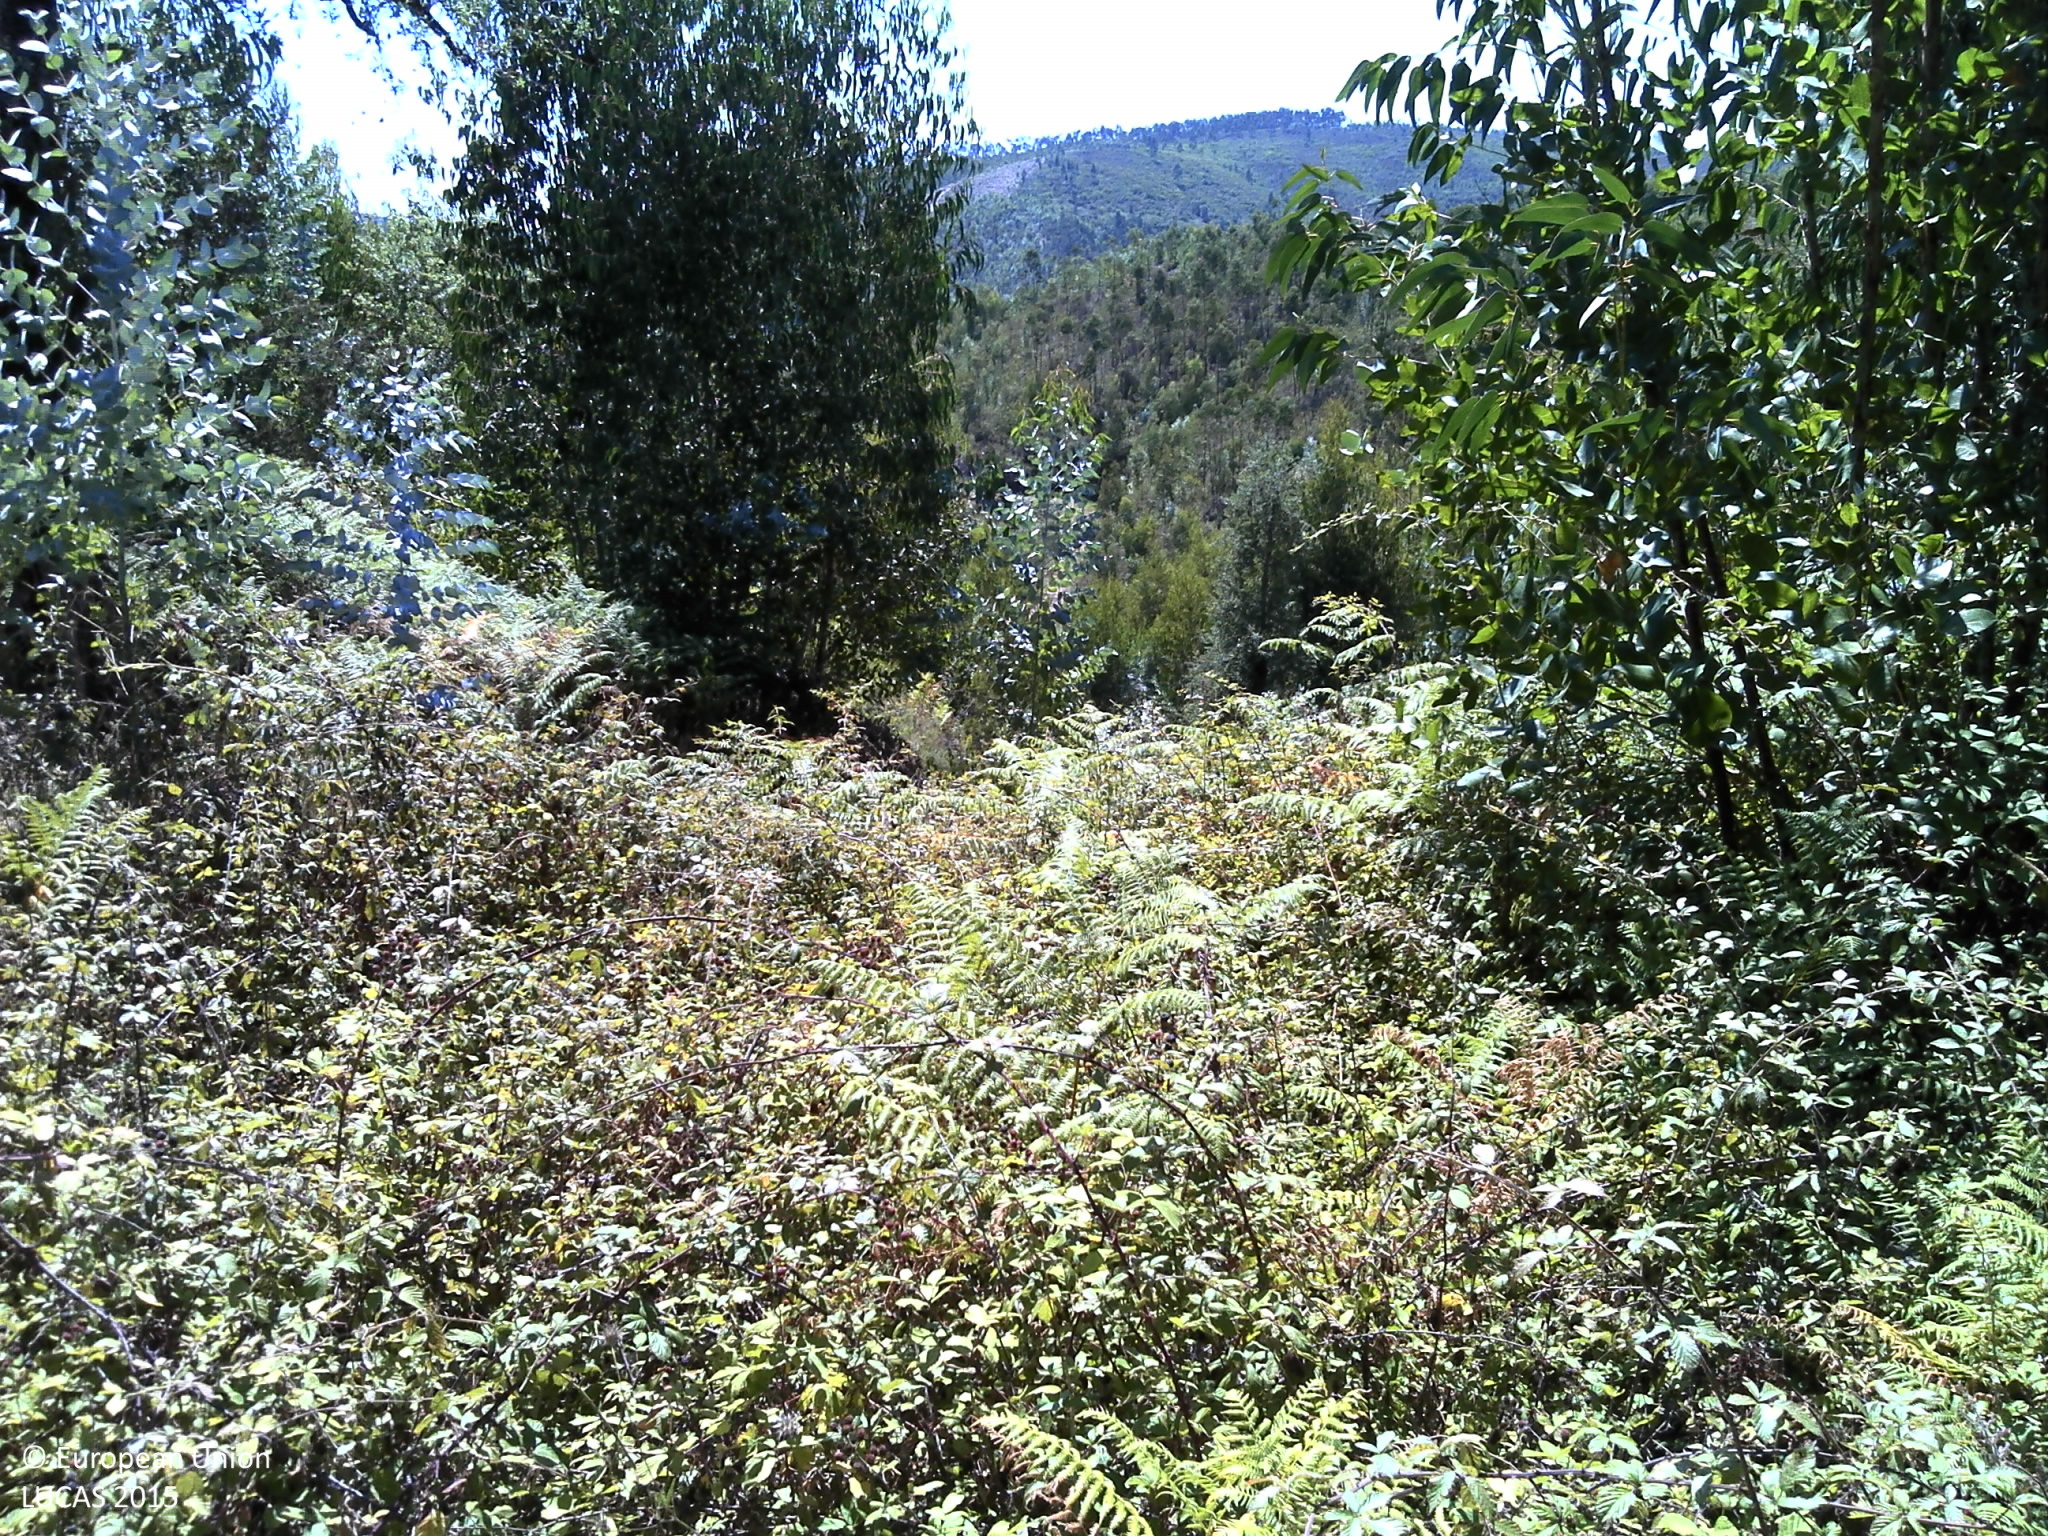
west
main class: Woodland
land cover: Broadleaved woodland
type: exotic forest
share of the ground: 50 - 75 %
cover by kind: broadleaved forest trees 60 %, shrubs 30 %, consolidated bare surface 10 %
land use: Forestry
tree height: > 5 m
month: August
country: PT
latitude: 37.3280
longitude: -8.6655
